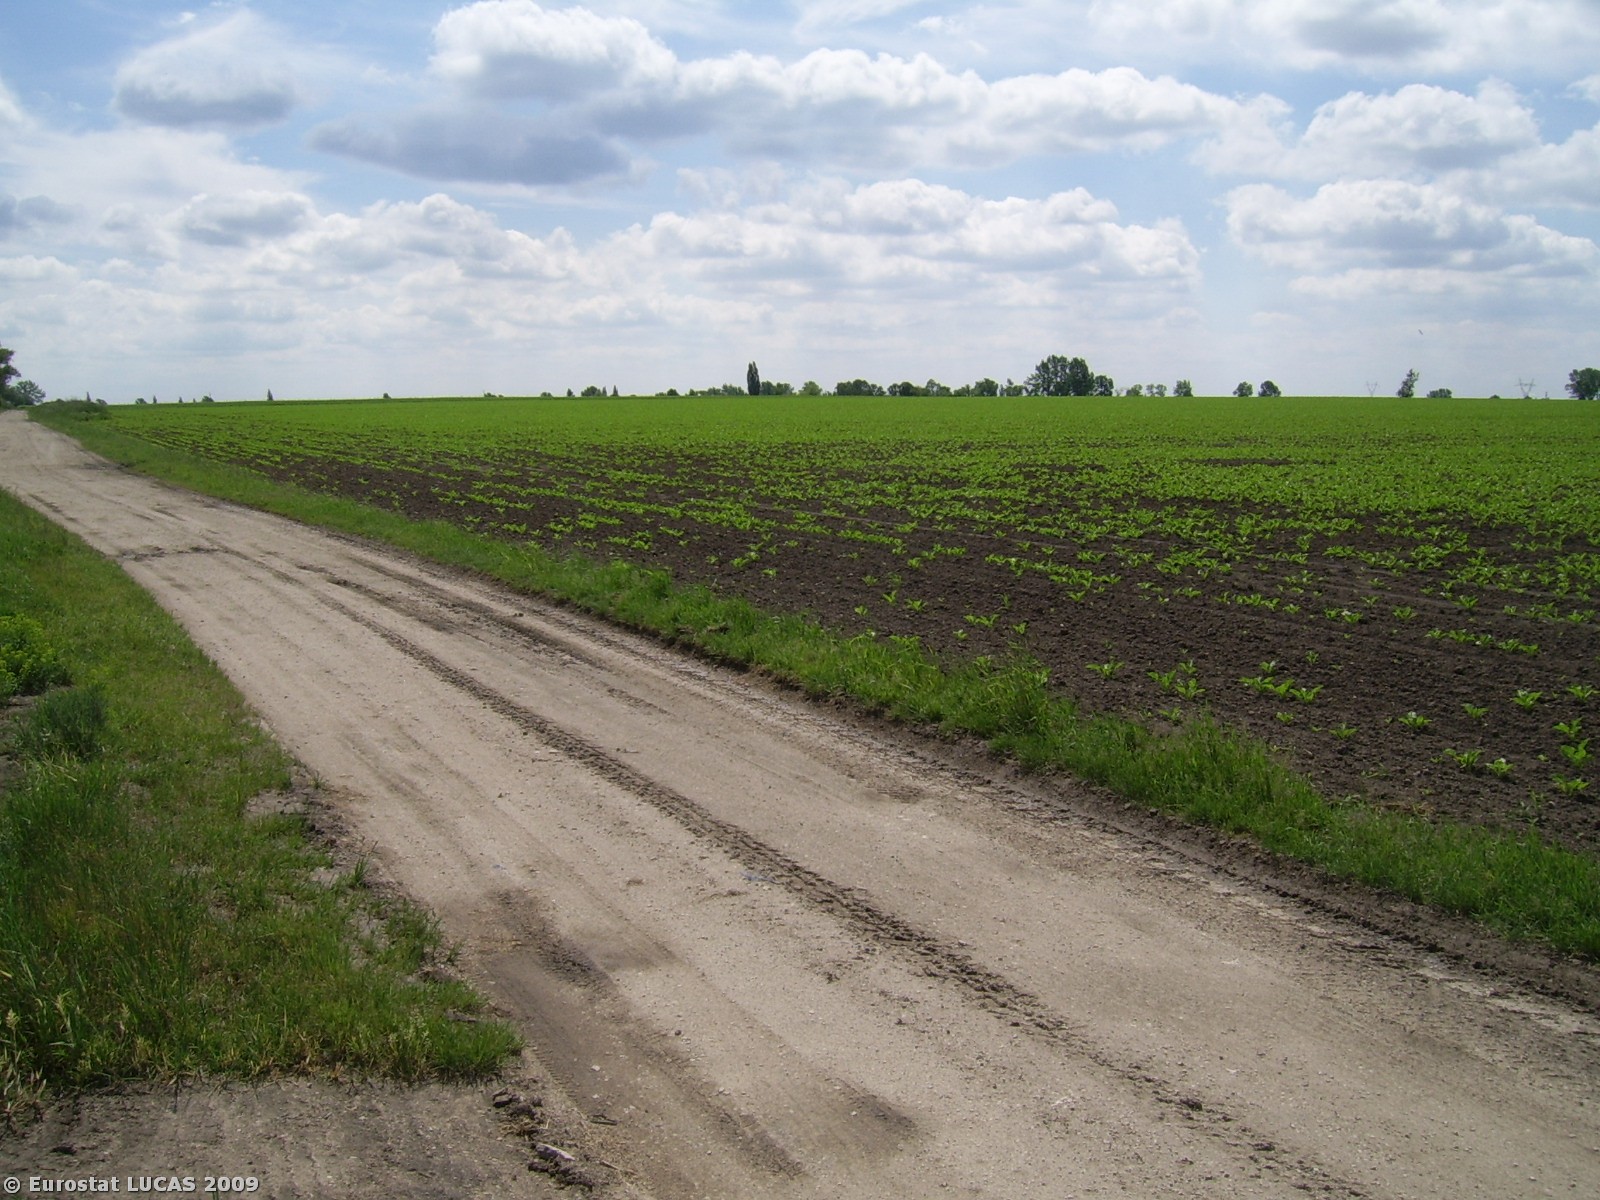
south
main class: Cropland
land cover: Common wheat
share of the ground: > 75 %
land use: Agriculture (excluding fallow land and kitchen gardens)
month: May
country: PL
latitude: 52.8189
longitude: 18.1628
